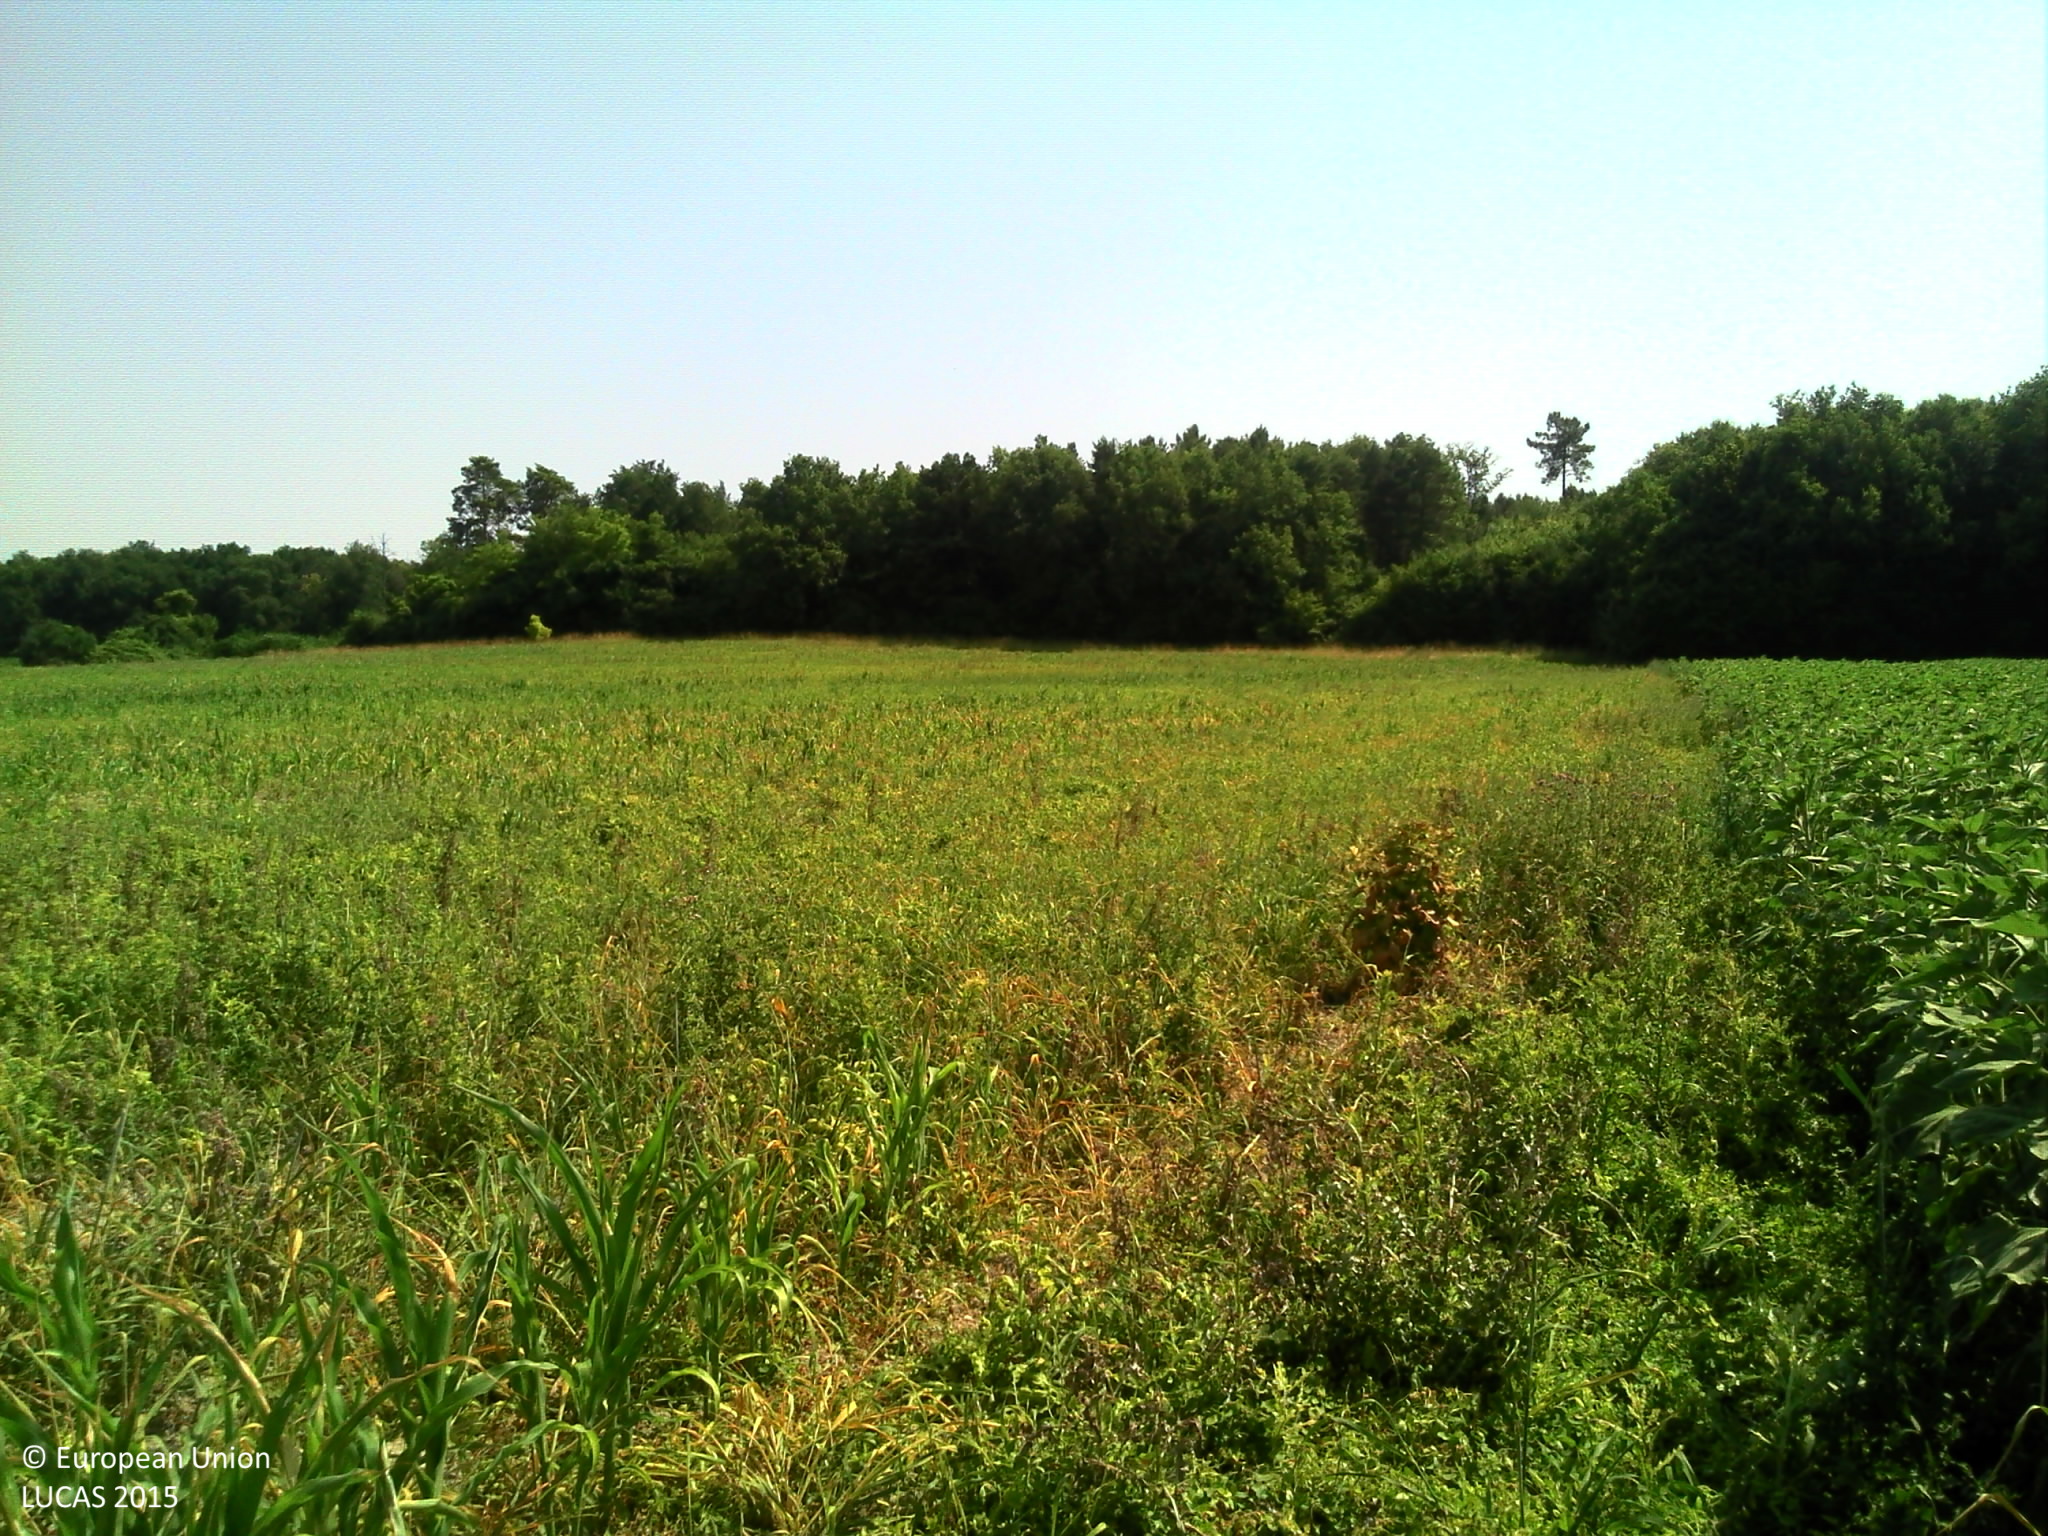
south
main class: Cropland
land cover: Sunflower
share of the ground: > 75 %
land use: Agriculture (excluding fallow land and kitchen gardens)
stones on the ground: < 10 %
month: July
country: FR
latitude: 46.8496
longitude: 0.4729
